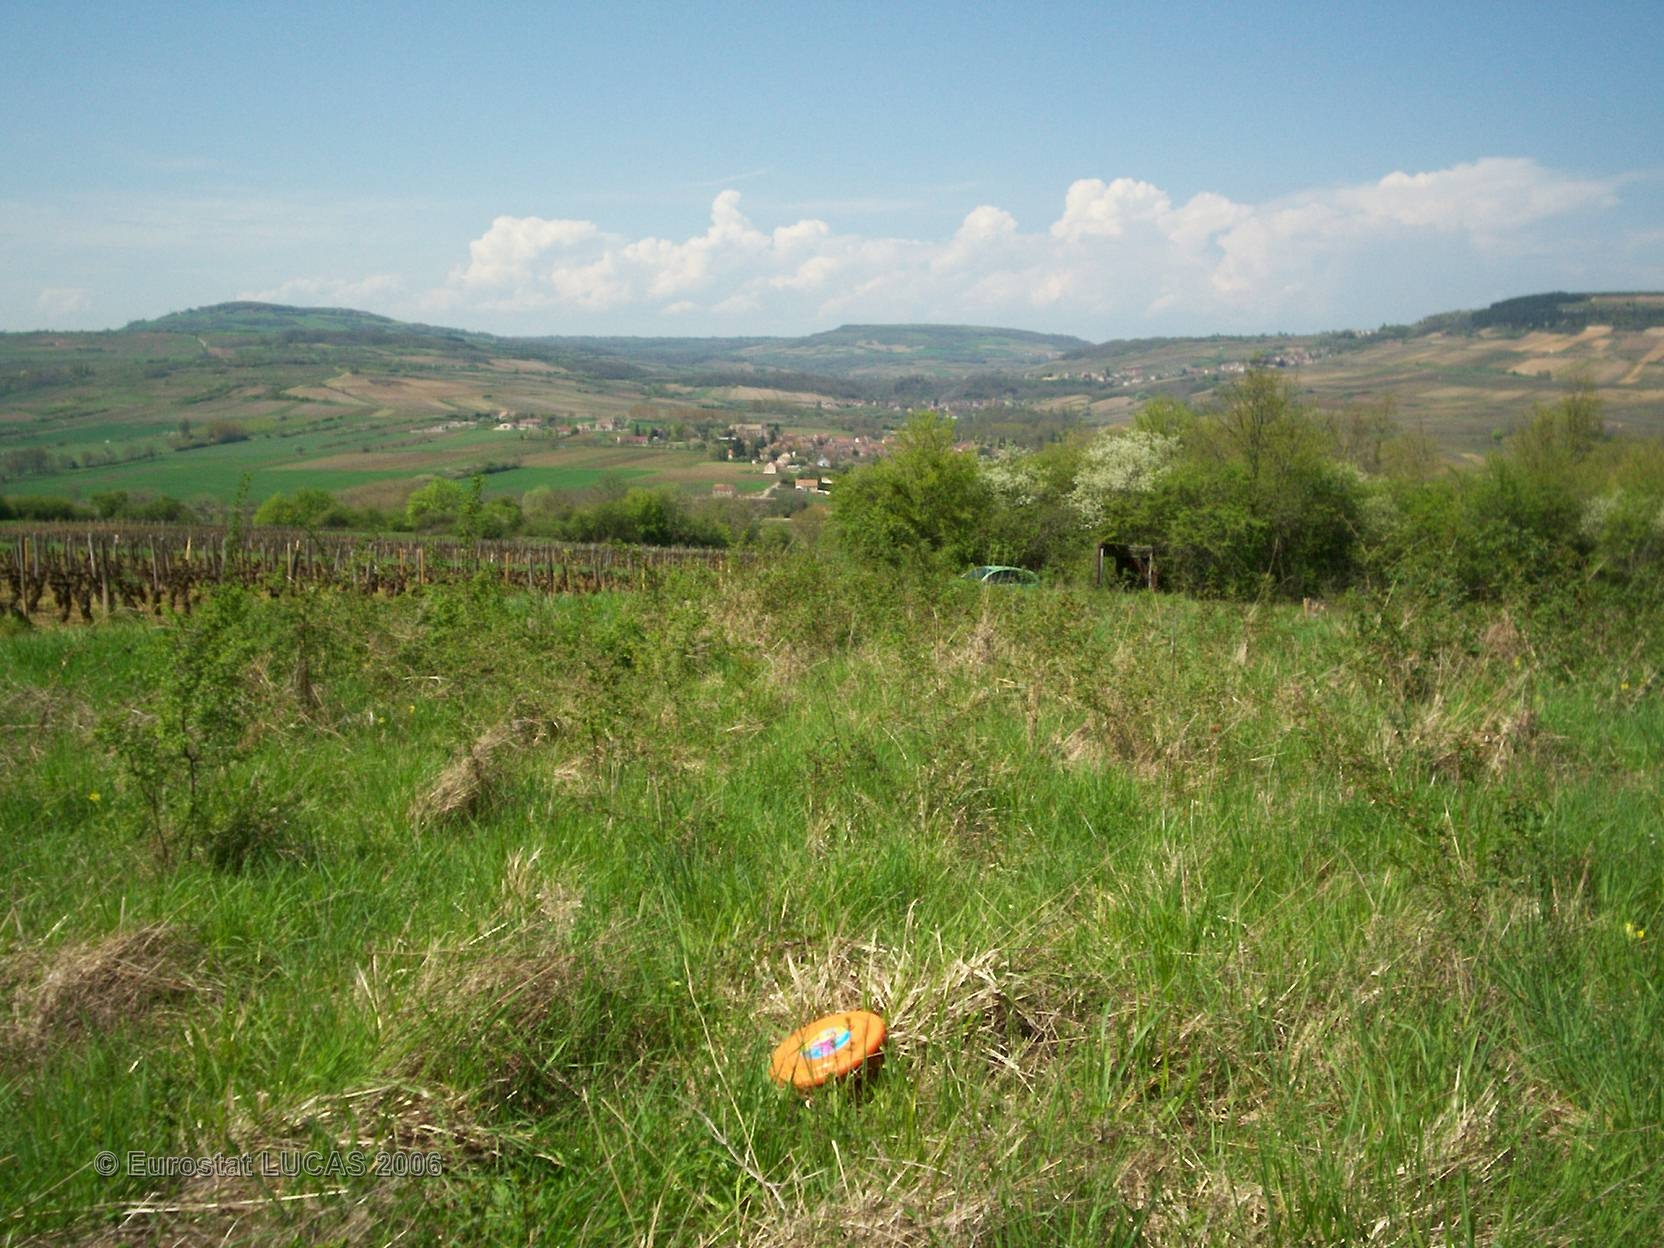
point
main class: Grassland
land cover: Grassland without tree/shrub cover
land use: Unused
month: April
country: FR
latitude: 46.8869
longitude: 4.6858
